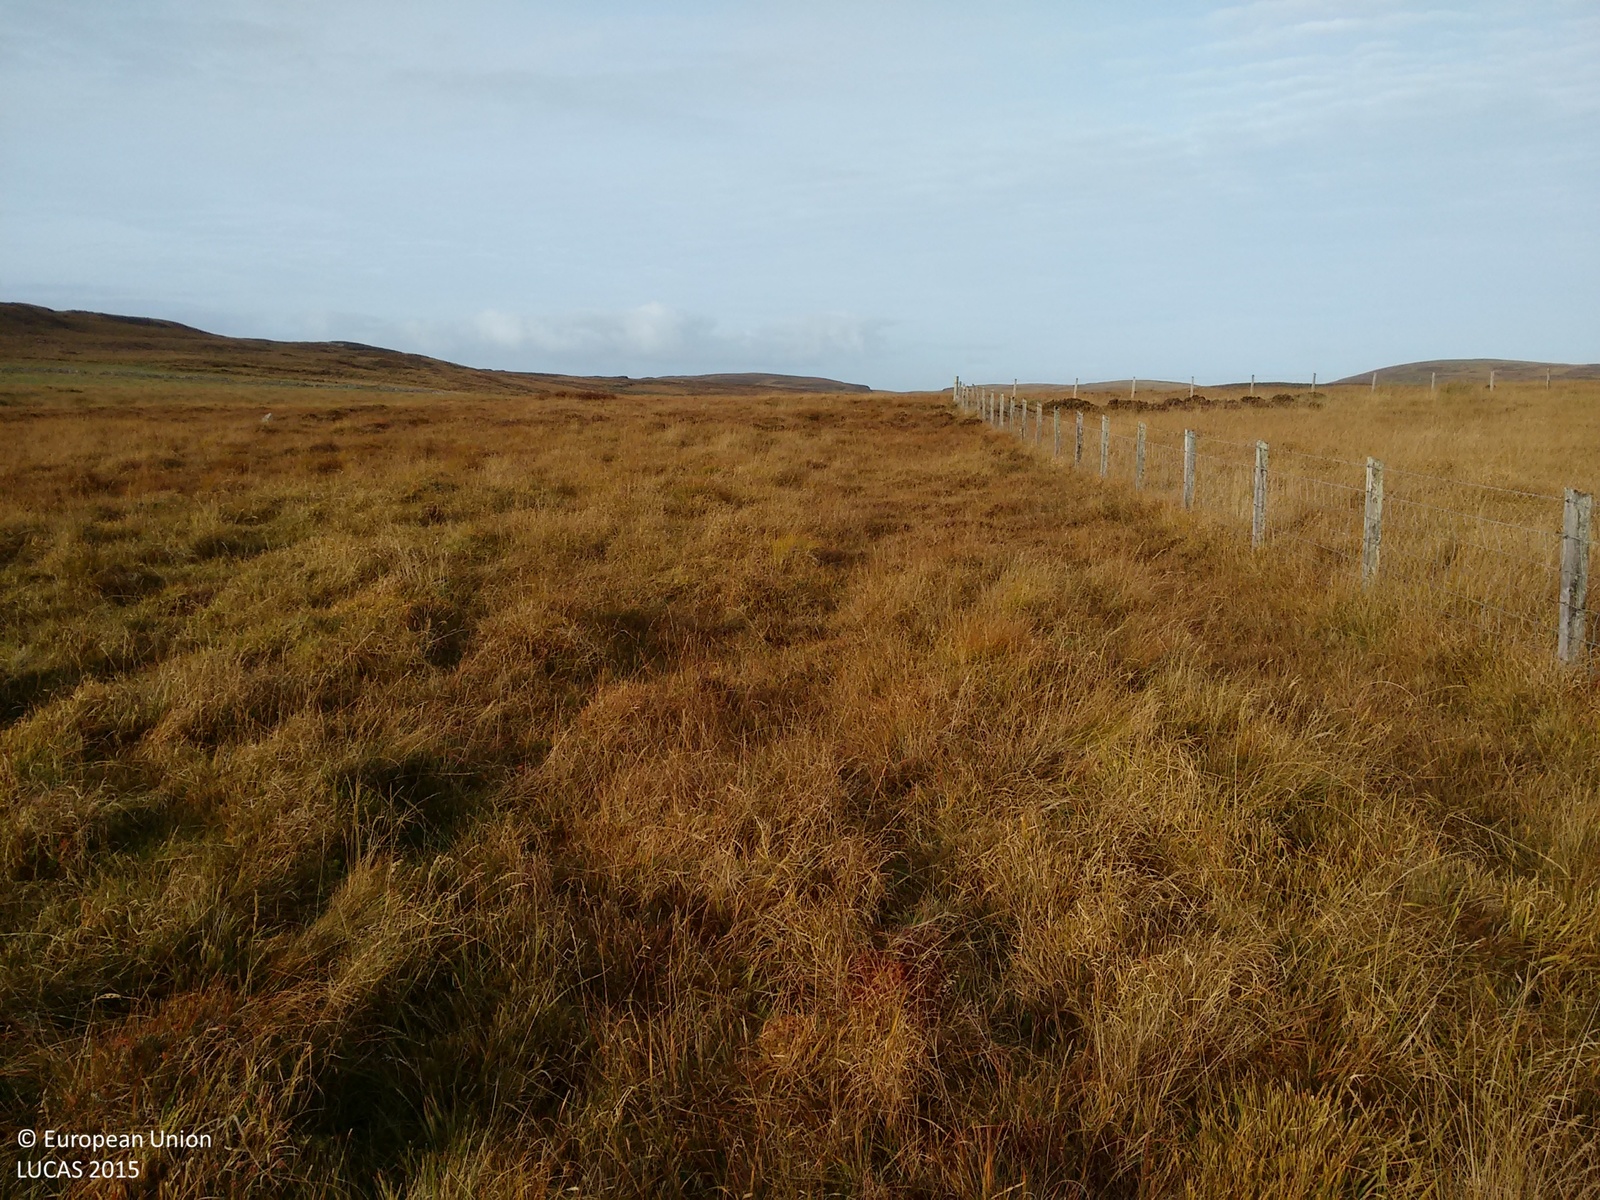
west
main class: Grassland
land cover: Grassland without tree/shrub cover
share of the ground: > 75 %
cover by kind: herbaceous plants 85 %, lichens and mosses 10 %, shrubs 5 %
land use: Agriculture (excluding fallow land and kitchen gardens)
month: October
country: GB
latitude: 55.8365
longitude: -6.4192
